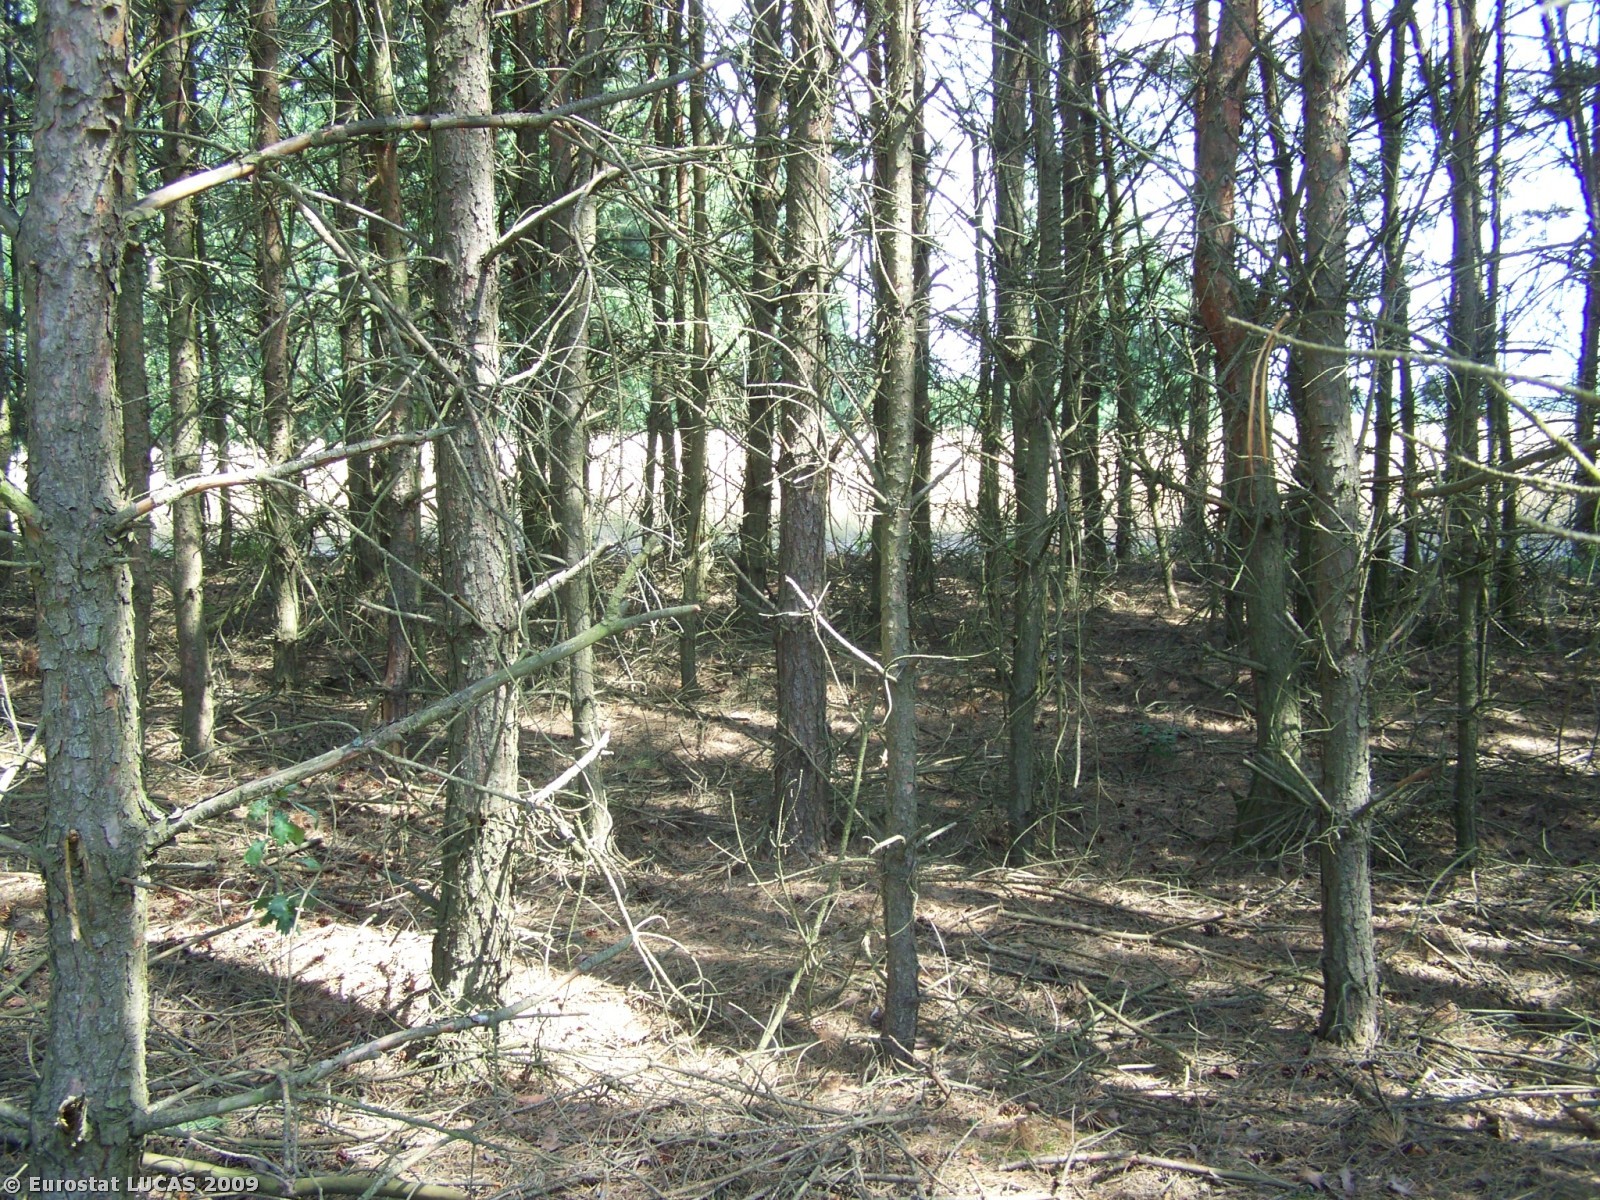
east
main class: Woodland
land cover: Coniferous woodland
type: hemiboreal forest and nemoral coniferous forest and mixed broadleaved-coniferous forest
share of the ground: > 75 %
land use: Forestry
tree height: > 5 m
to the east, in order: Coniferous woodland; Tracks; Rye; Grass margins; Oats; Grassland without tree/shrub cover; Oats; Lines of trees; Grassland without tree/shrub cover; Ditches and canals; Grass margins; Tracks; Grass margins; Ditches and canals; Fences; Grassland without tree/shrub cover
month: July
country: PL
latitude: 52.0772
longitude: 22.1568
